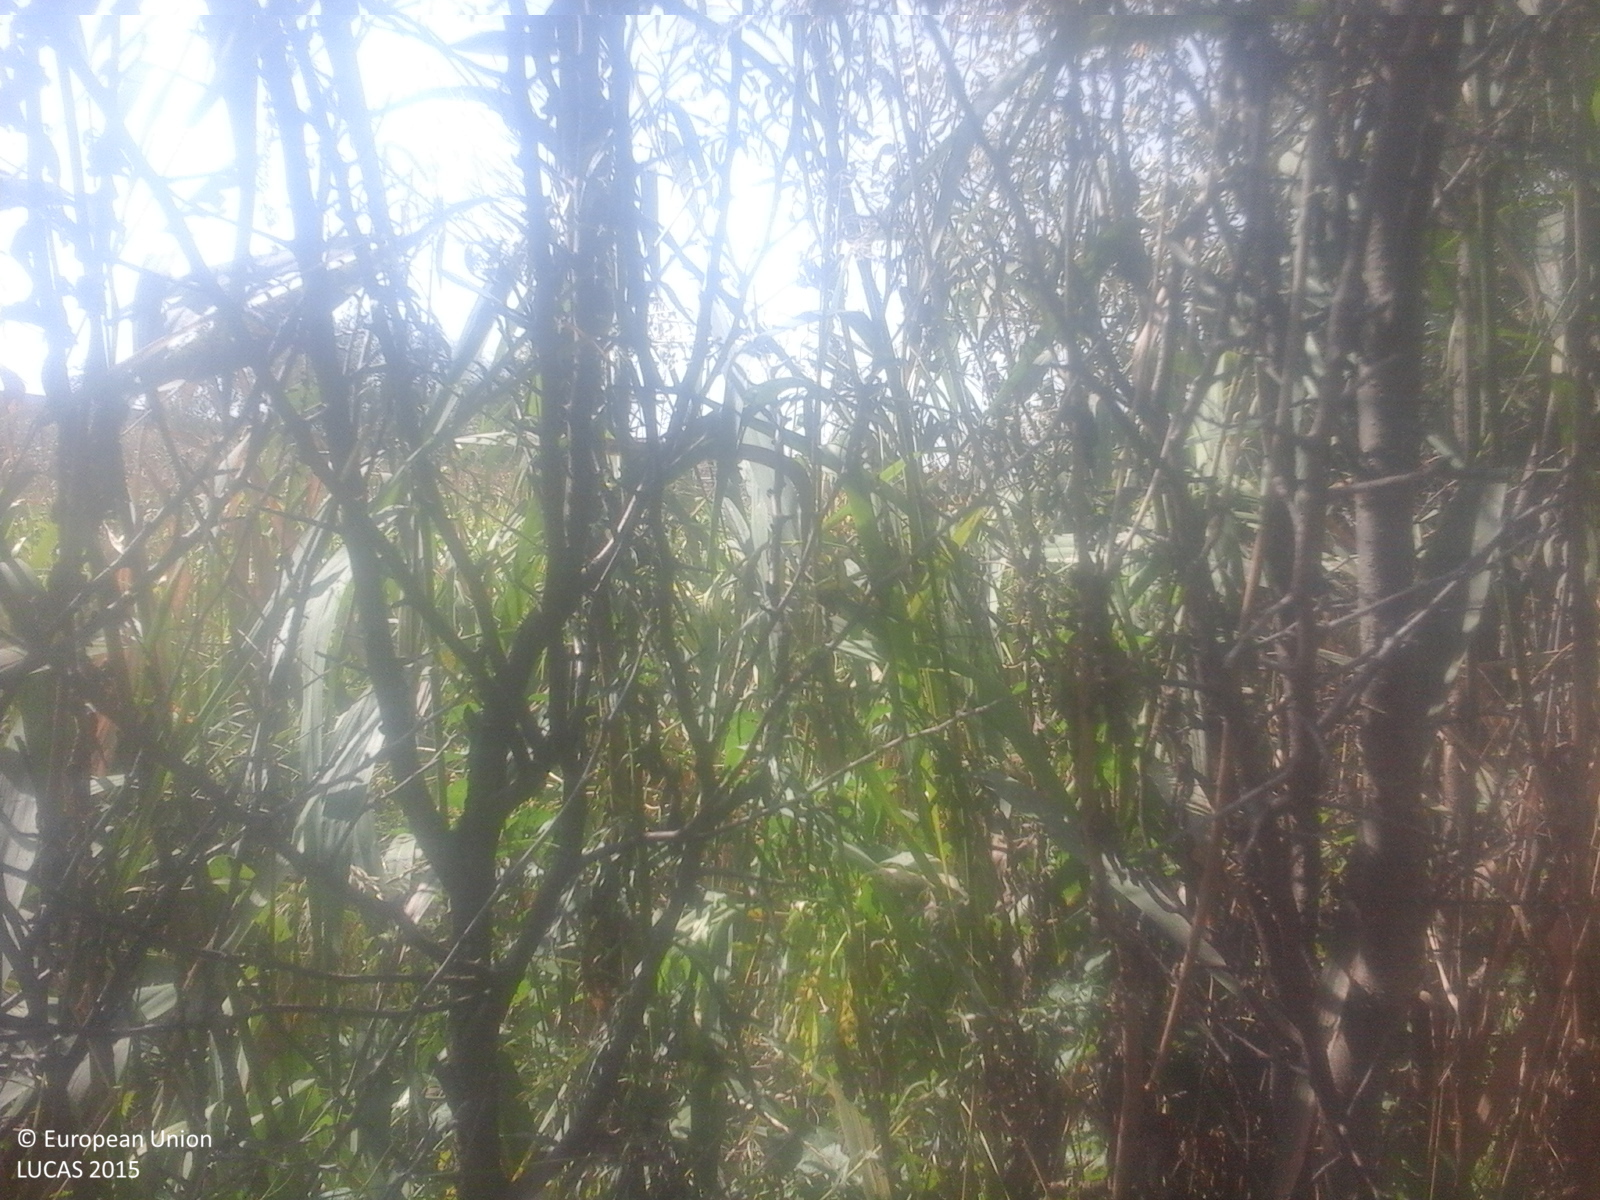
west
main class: Cropland
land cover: Maize
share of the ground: > 75 %
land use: Agriculture (excluding fallow land and kitchen gardens)
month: September
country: RO
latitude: 46.8977
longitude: 24.3278
